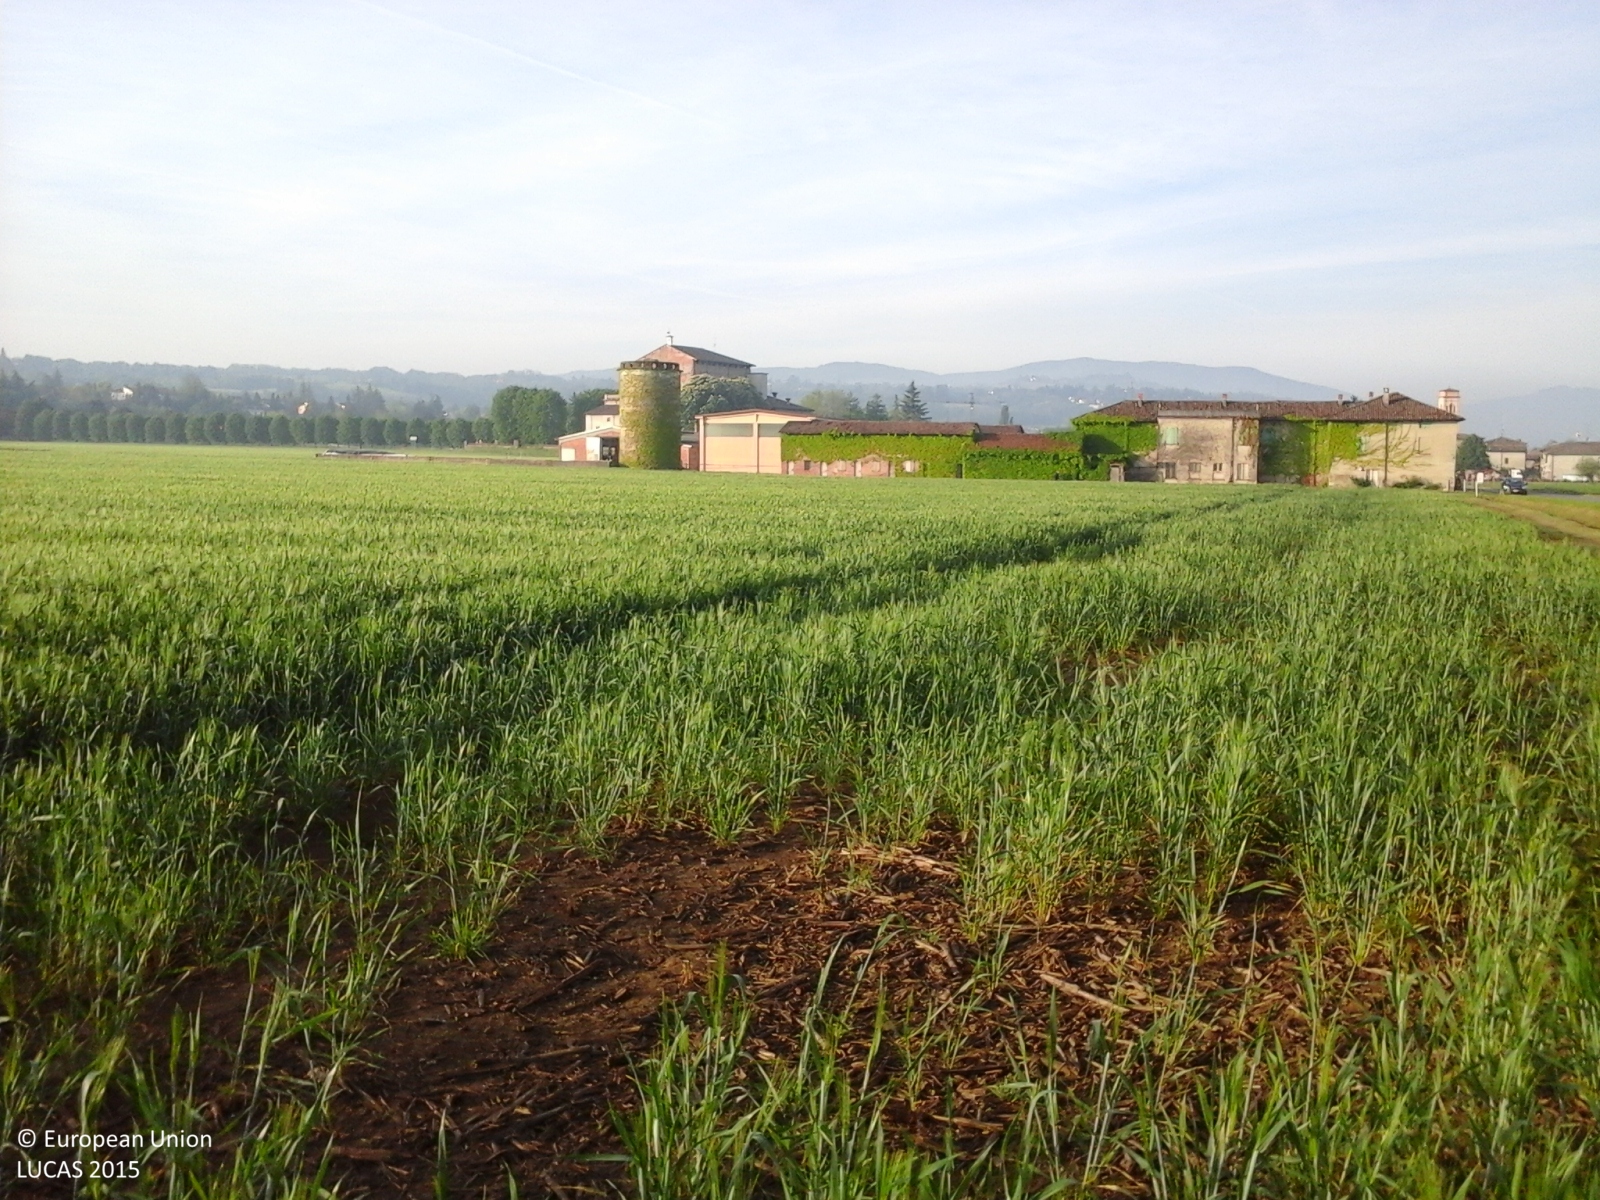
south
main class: Cropland
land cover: Common wheat
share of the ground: > 75 %
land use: Agriculture (excluding fallow land and kitchen gardens)
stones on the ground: < 10 %
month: May
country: IT
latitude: 44.9269
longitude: 9.6080
